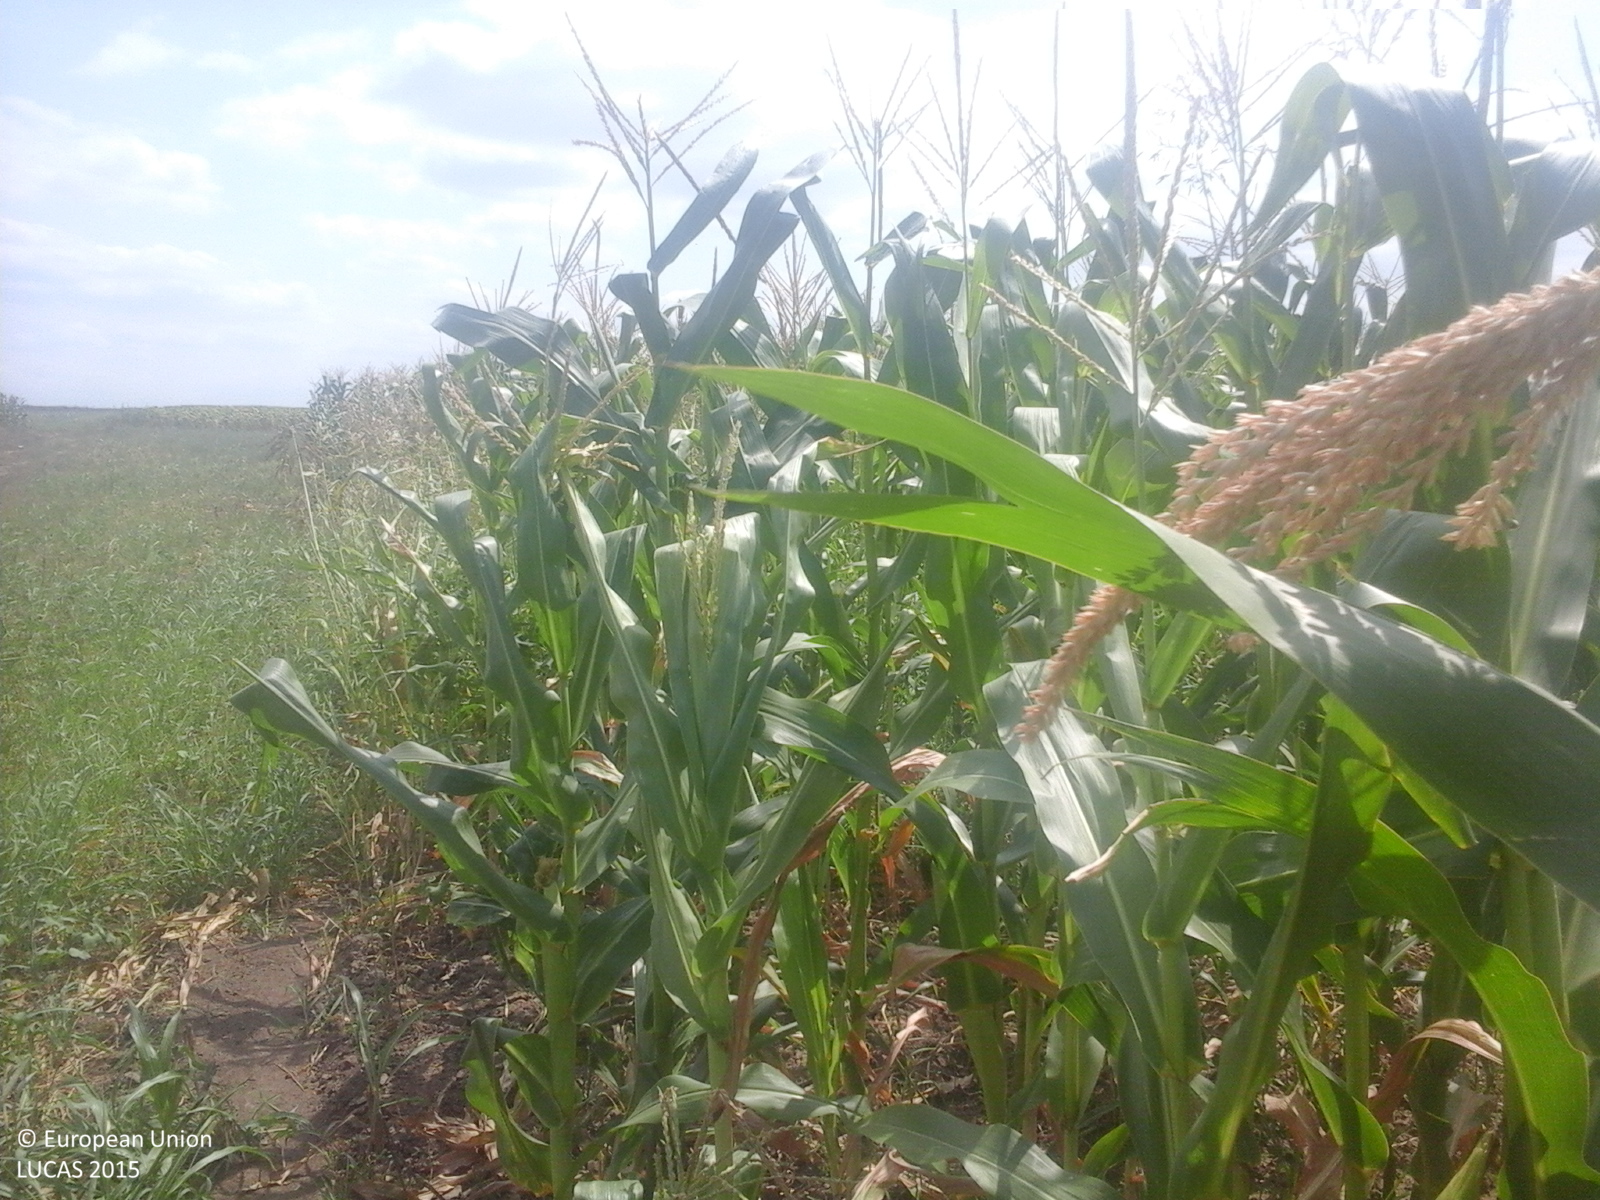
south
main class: Cropland
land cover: Maize
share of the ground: > 75 %
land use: Agriculture (excluding fallow land and kitchen gardens)
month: August
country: RO
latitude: 44.6900
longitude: 28.2495
